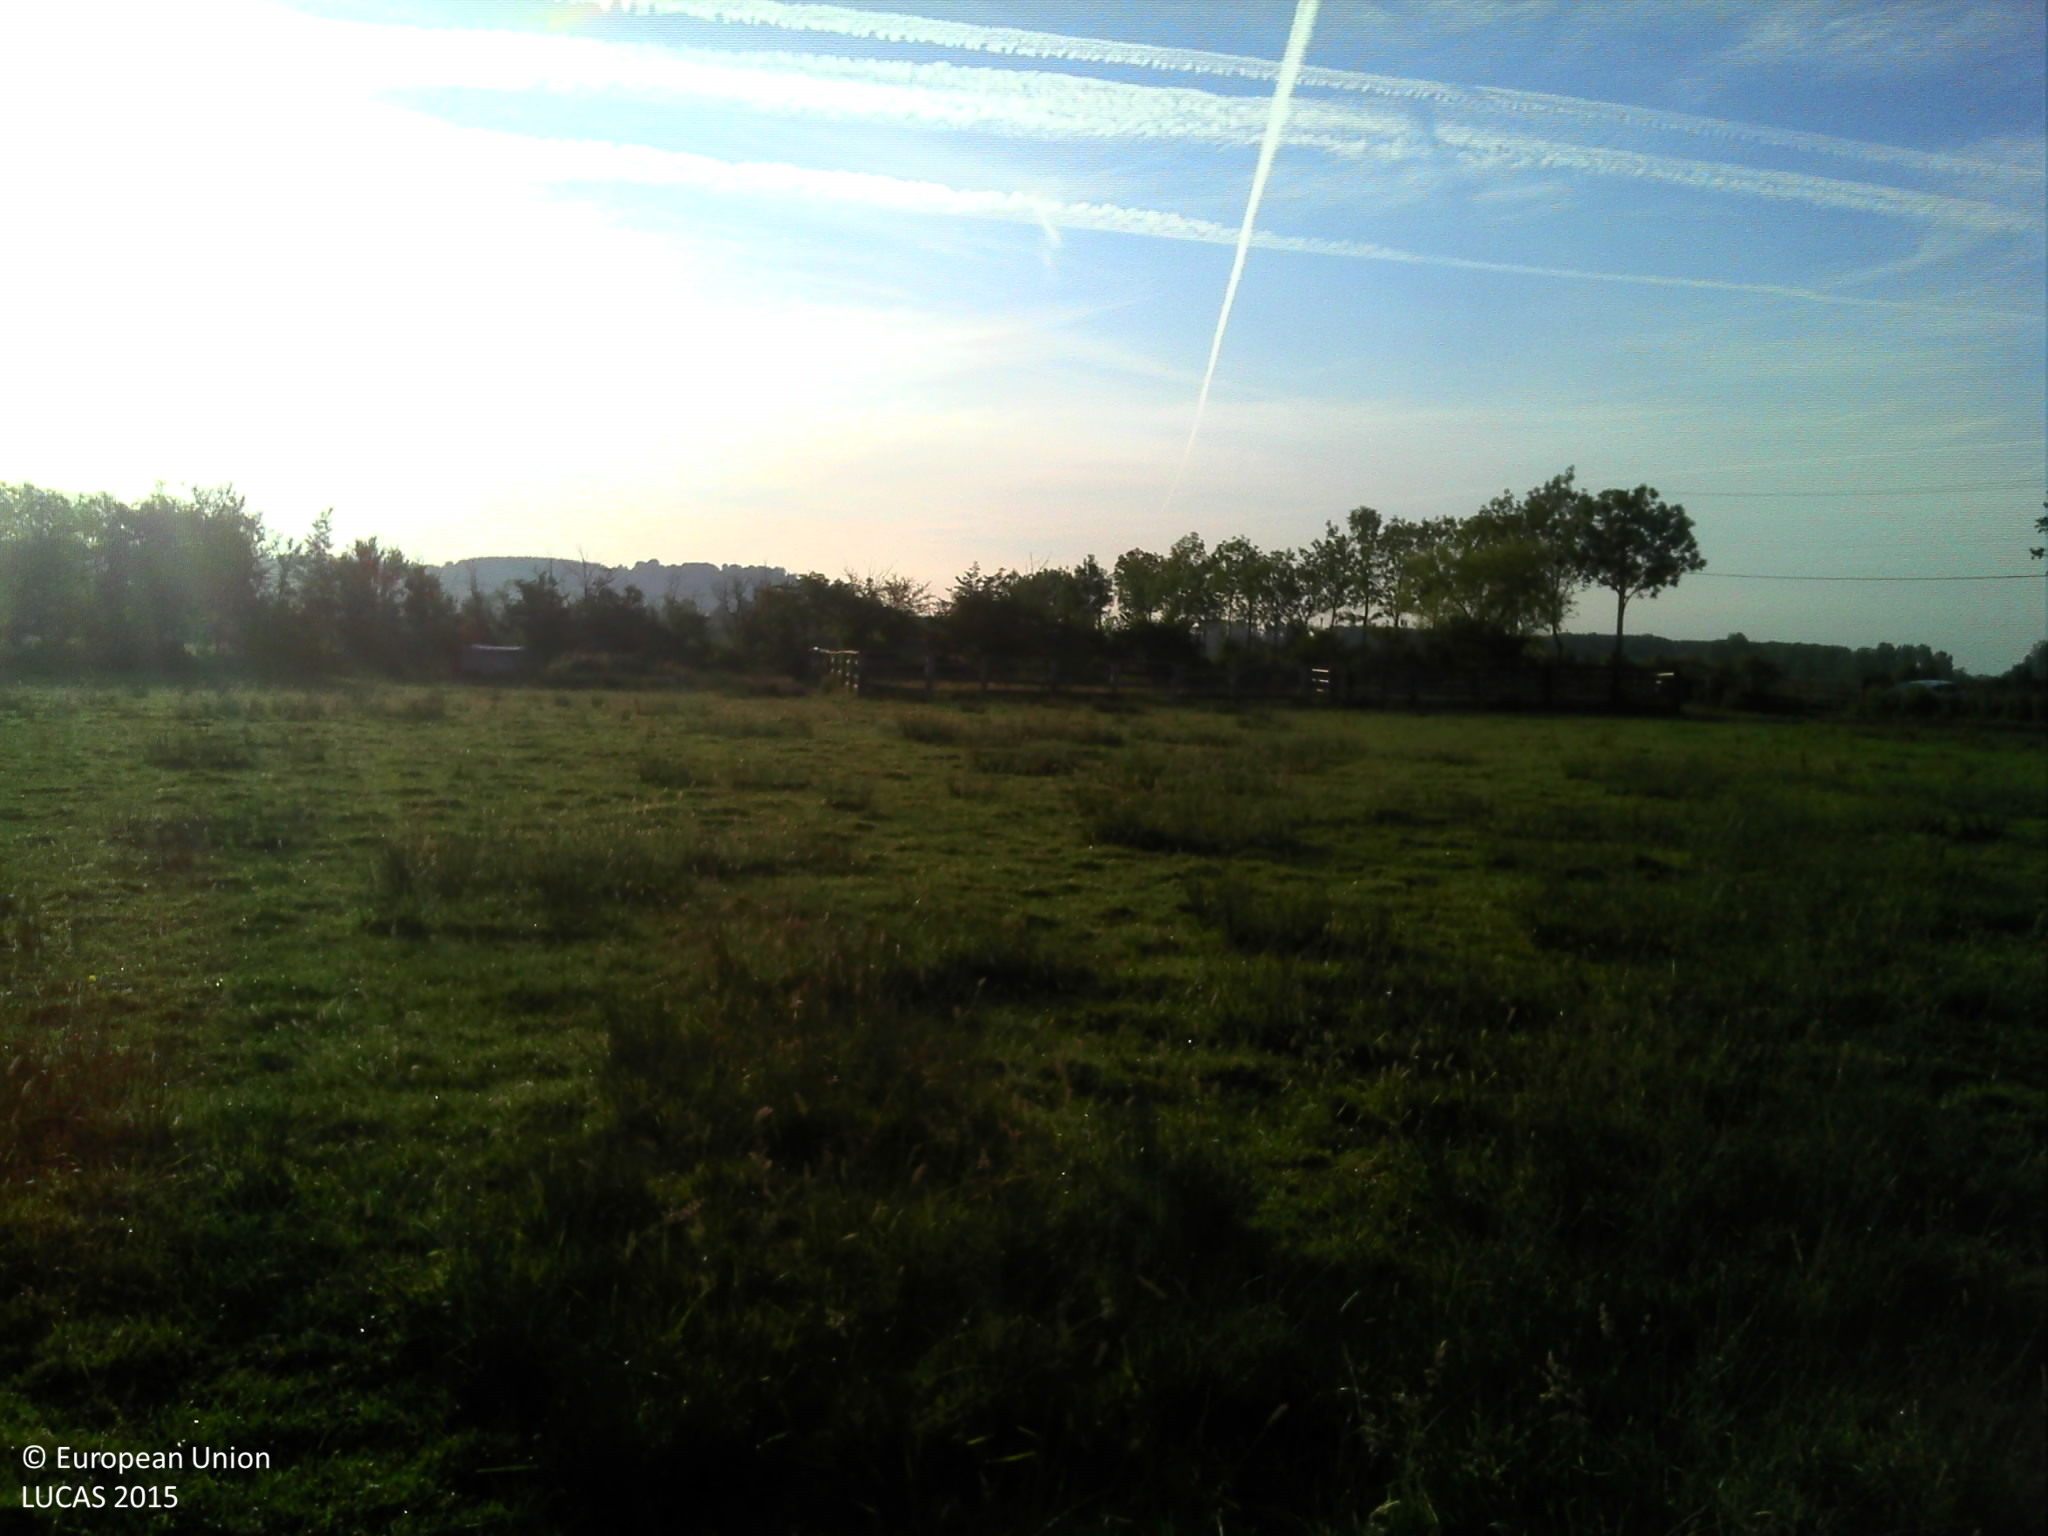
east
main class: Grassland
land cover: Grassland without tree/shrub cover
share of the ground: > 75 %
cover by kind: herbaceous plants 100 %
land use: Agriculture (excluding fallow land and kitchen gardens)
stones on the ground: < 10 %
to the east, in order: Grassland without tree/shrub cover; Ditches and canals; Abandoned hedges; Fences; Grassland without tree/shrub cover; Fences; Electric lines; Grass margins; Paved roads, cycling and walking lanes; Grass margins; Electric lines; Fences; Abandoned hedges; Grassland without tree/shrub cover
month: June
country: FR
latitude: 49.1254
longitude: -0.0209
